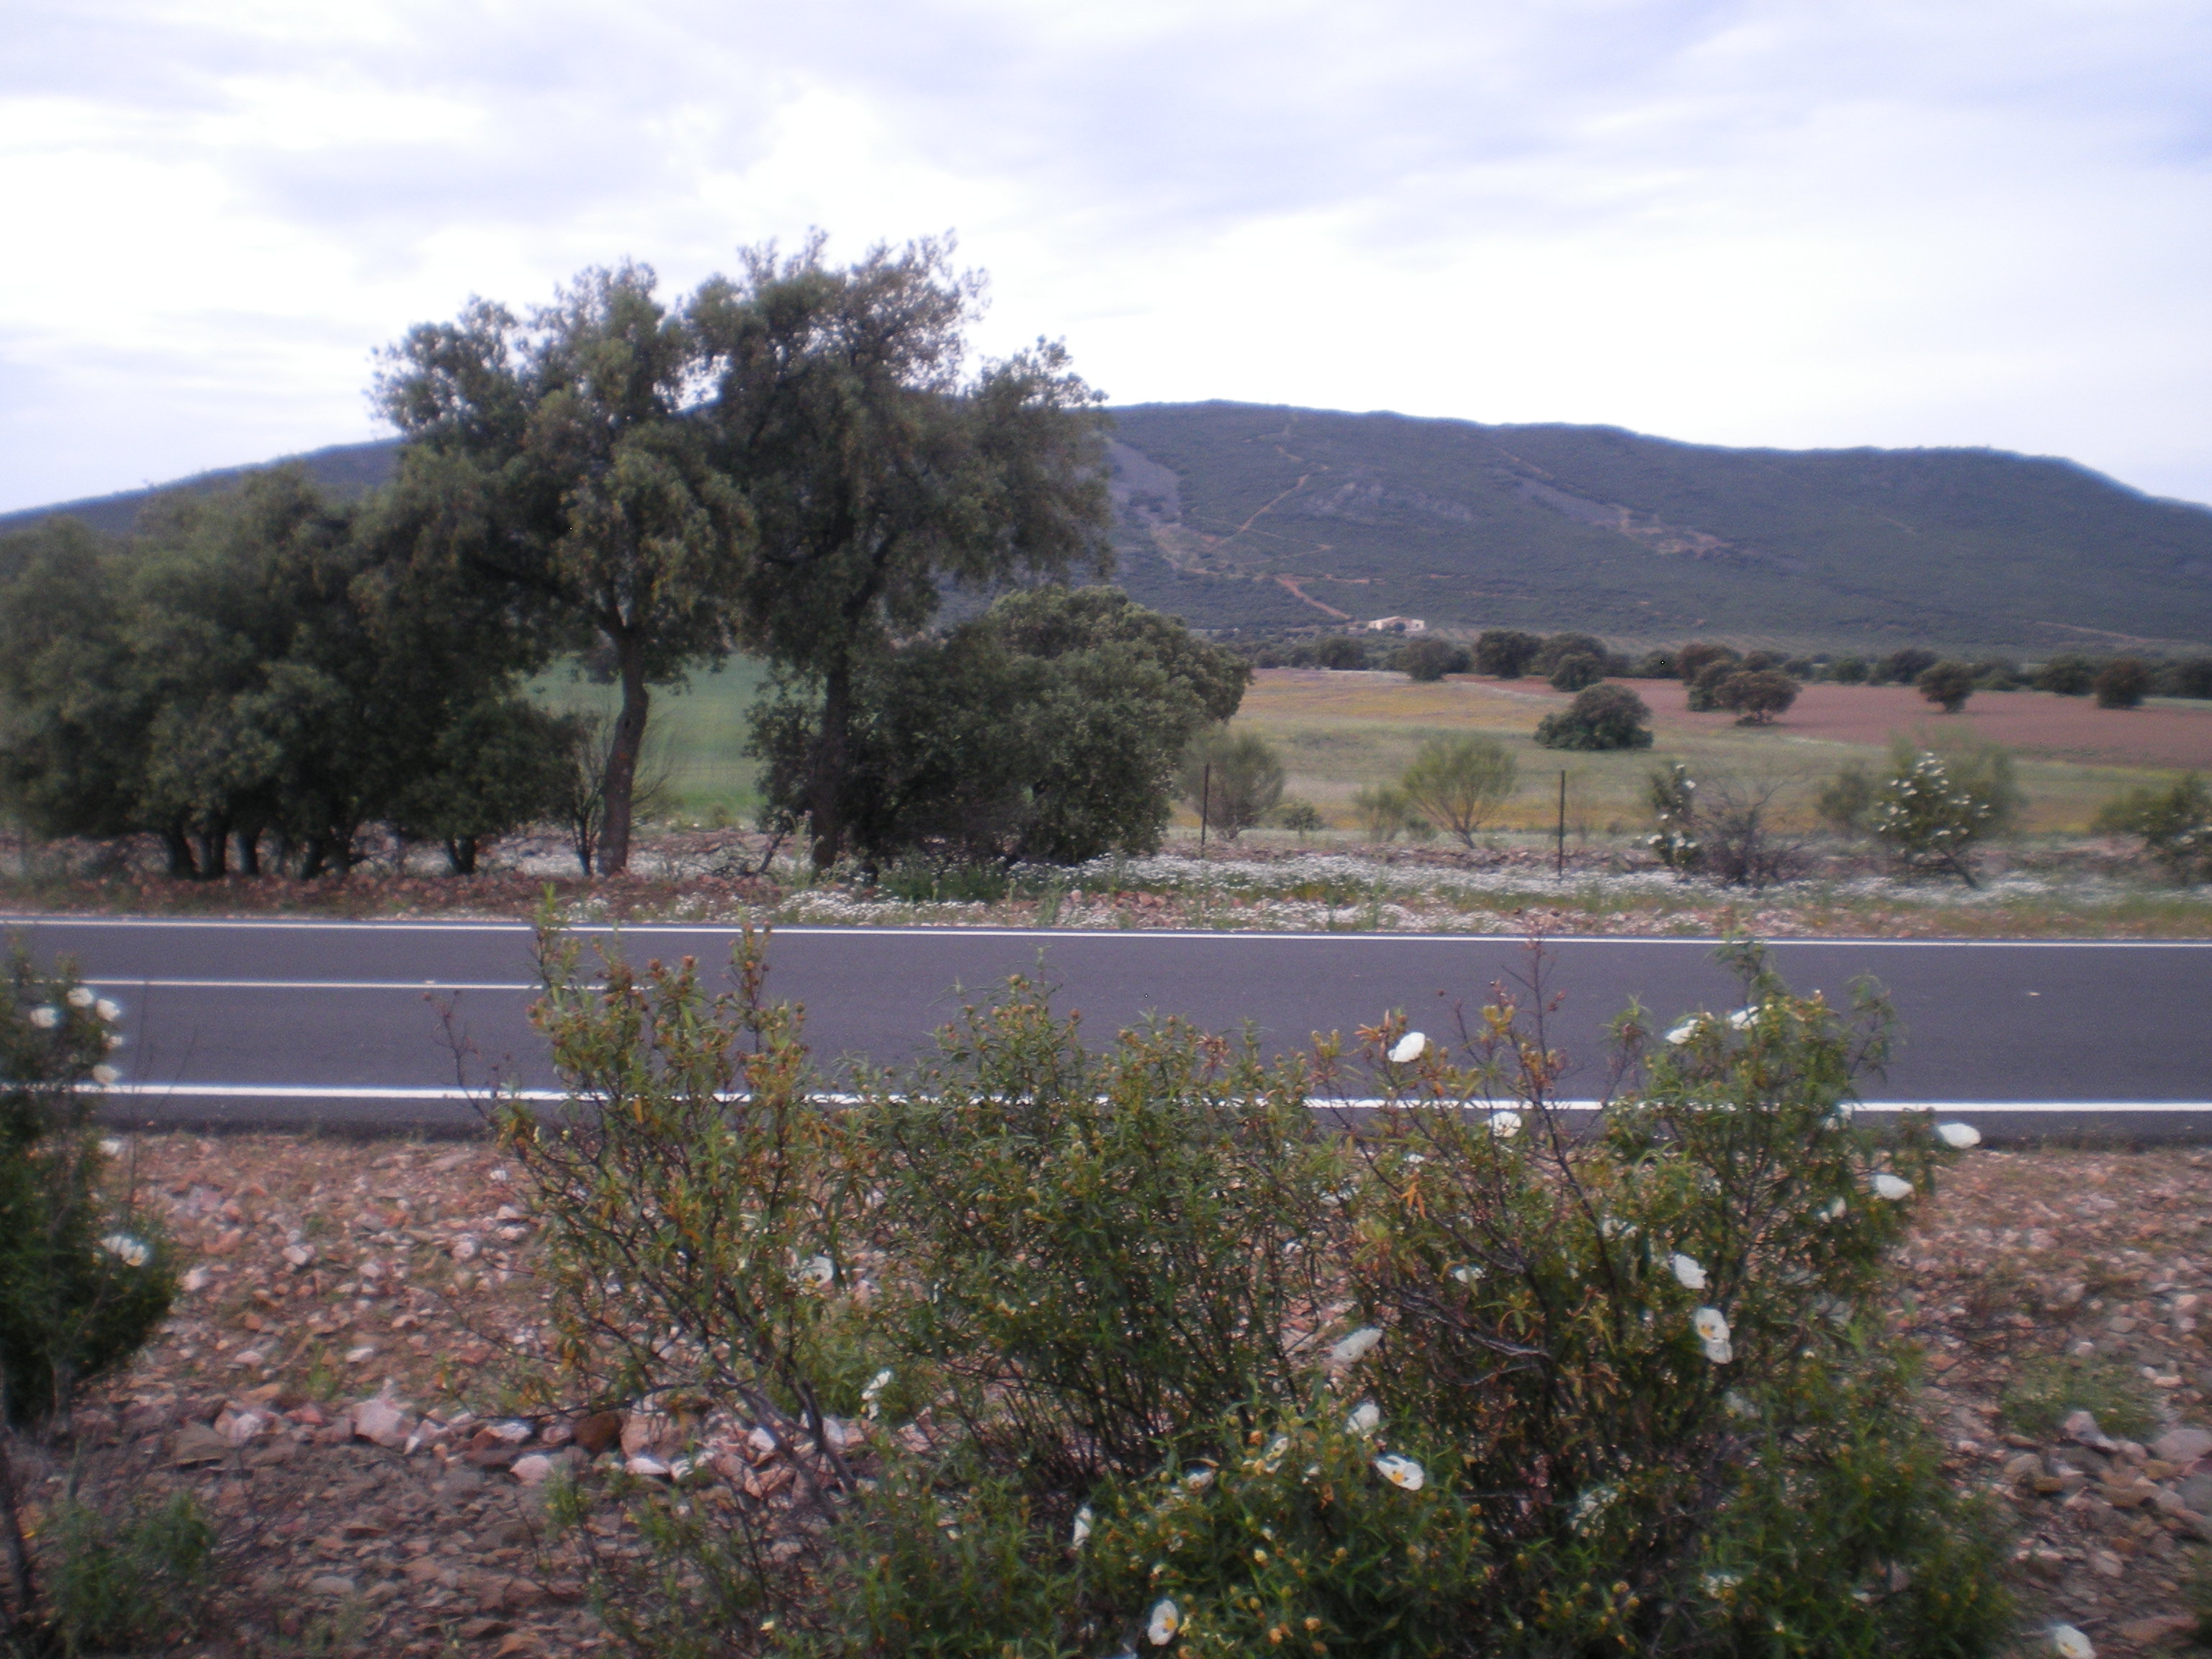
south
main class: Cropland
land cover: Oats
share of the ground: > 75 %
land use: Agriculture (excluding fallow land and kitchen gardens)
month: May
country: ES
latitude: 38.6553
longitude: -3.2110
